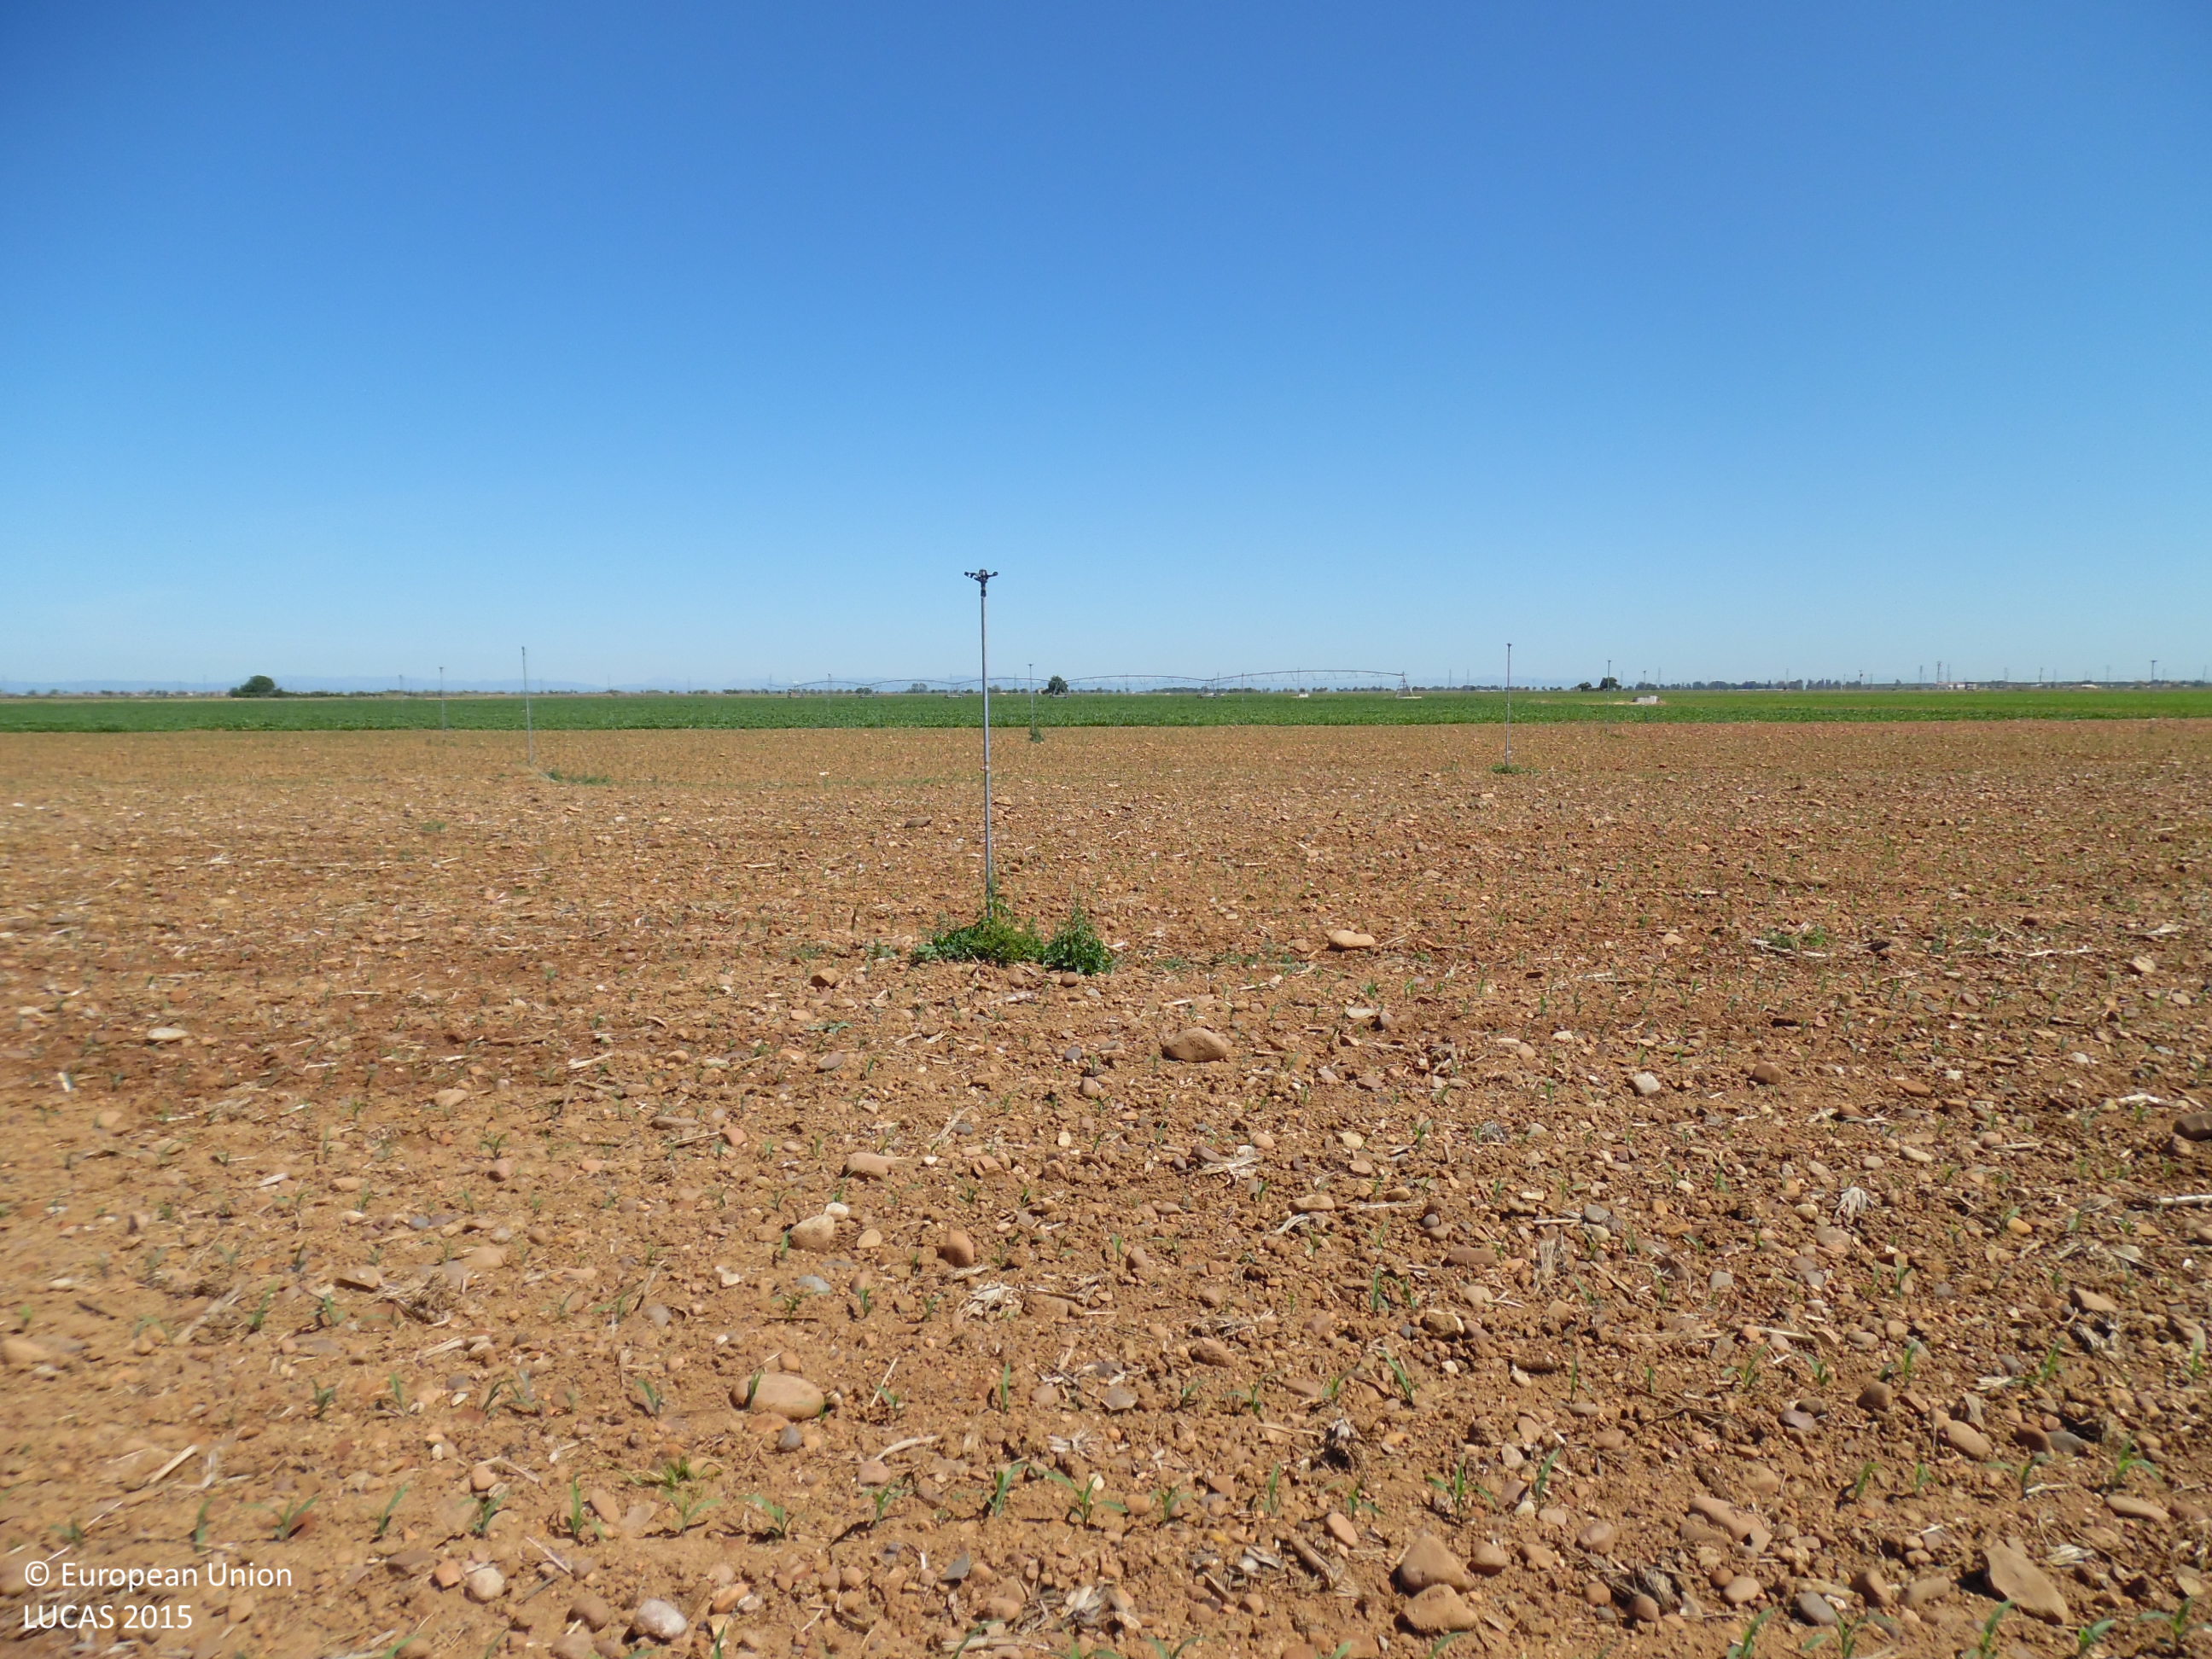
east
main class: Cropland
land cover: Maize
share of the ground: < 10 %
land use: Agriculture (excluding fallow land and kitchen gardens)
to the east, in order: Maize; Tracks; Maize
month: June
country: ES
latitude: 42.3010
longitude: -5.7078
